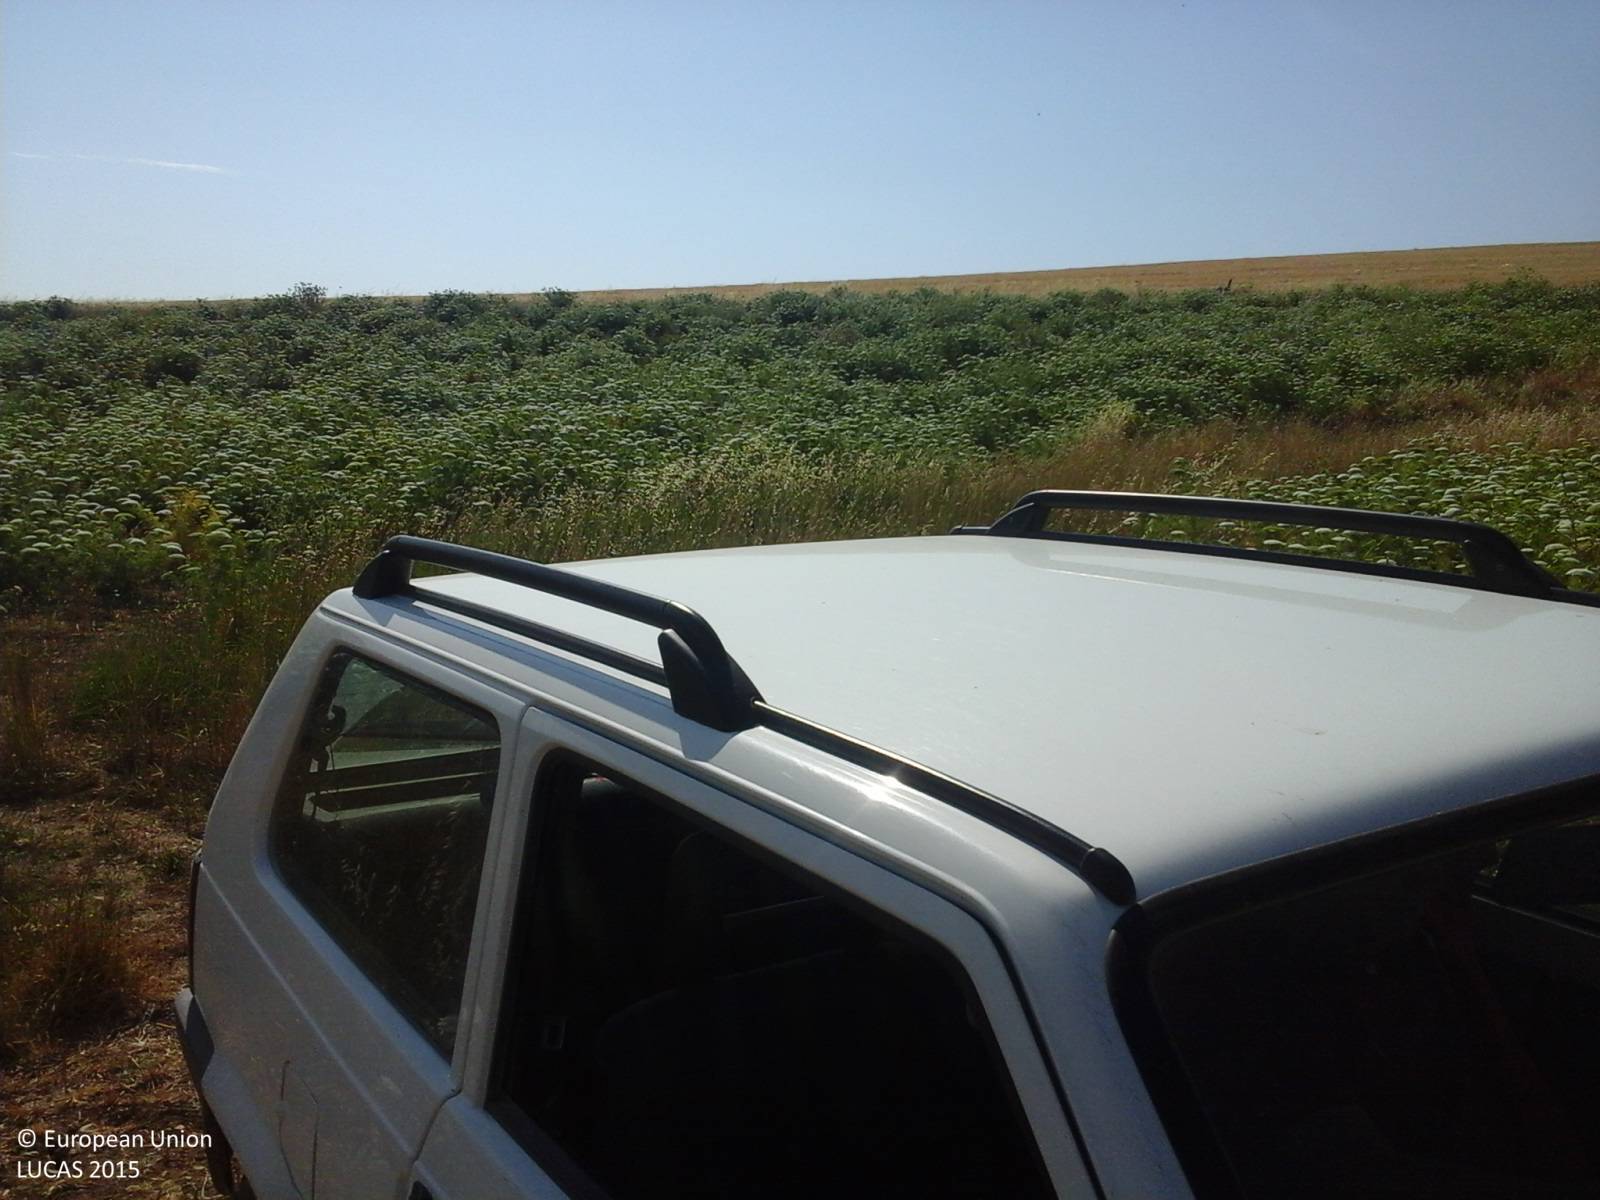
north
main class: Cropland
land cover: Other leguminous and mixtures for fodder
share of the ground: > 75 %
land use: Agriculture (excluding fallow land and kitchen gardens)
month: June
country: IT
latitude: 37.8909
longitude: 12.6979
